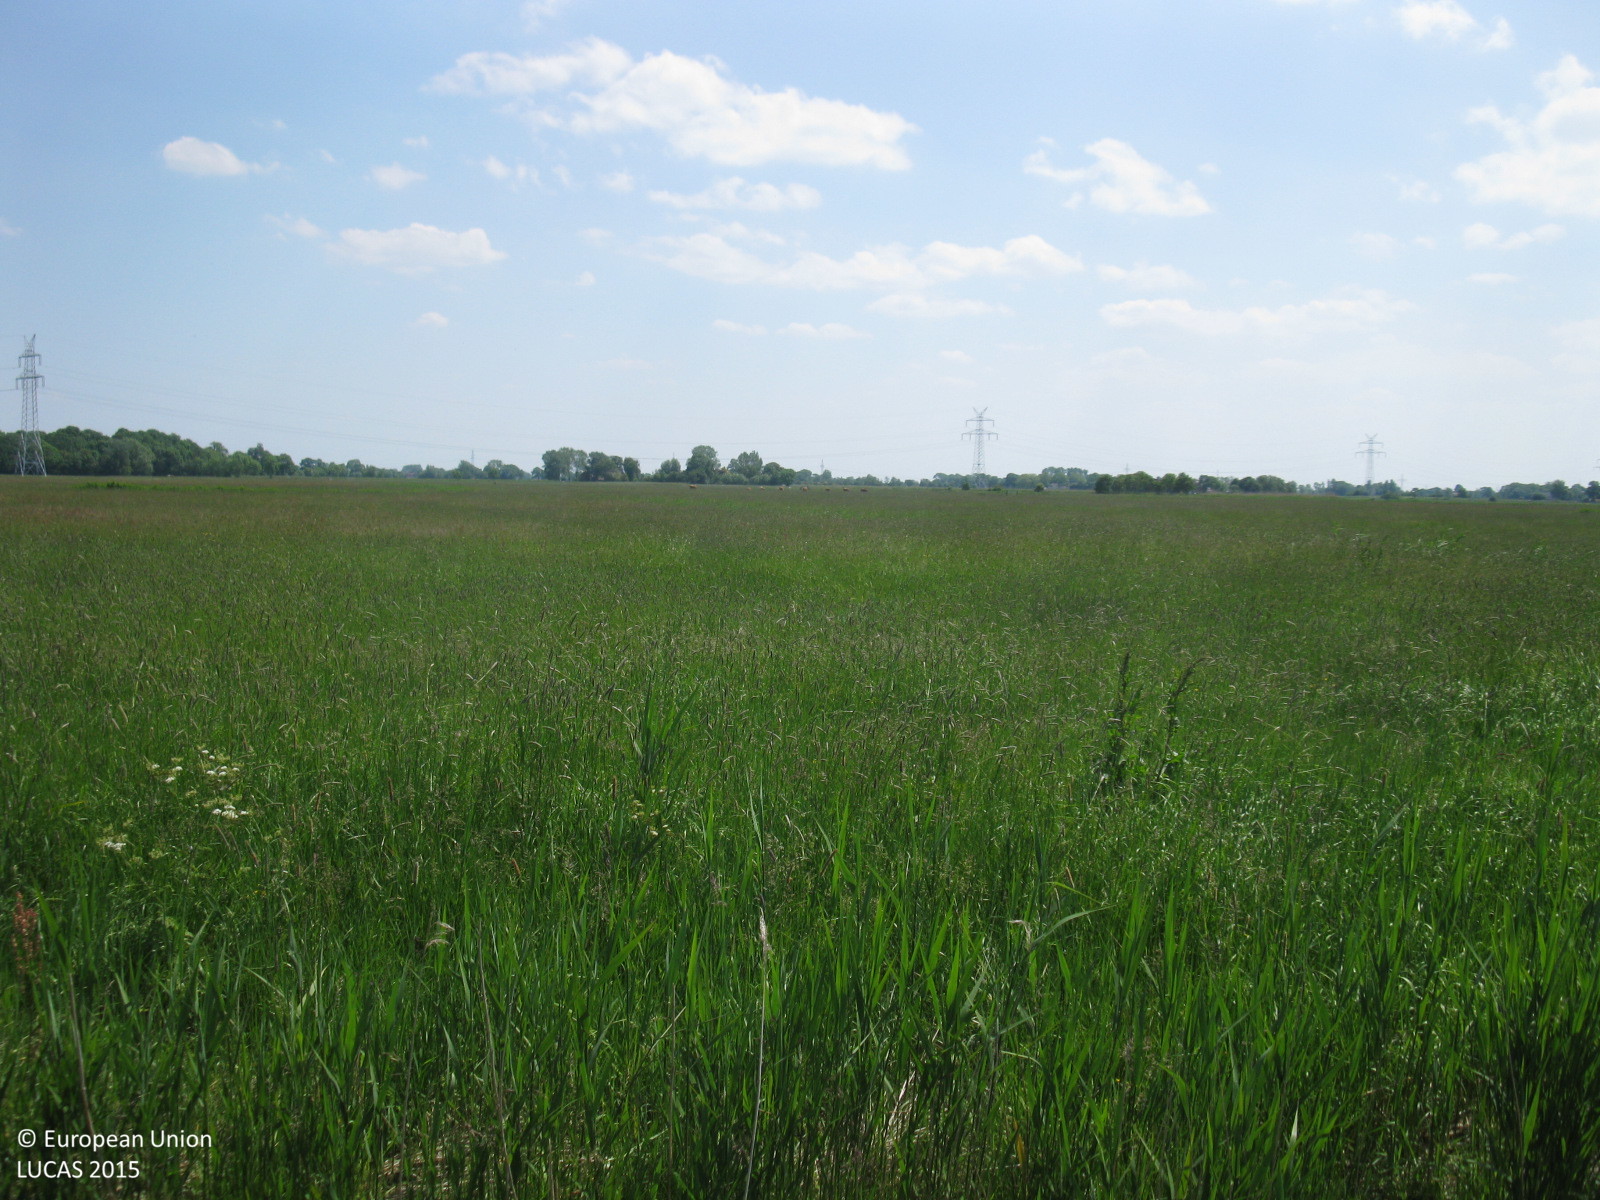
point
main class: Grassland
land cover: Grassland without tree/shrub cover
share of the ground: > 75 %
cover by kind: herbaceous plants 100 %
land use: Agriculture (excluding fallow land and kitchen gardens)
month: June
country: DE
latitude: 53.4815
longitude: 8.4184
